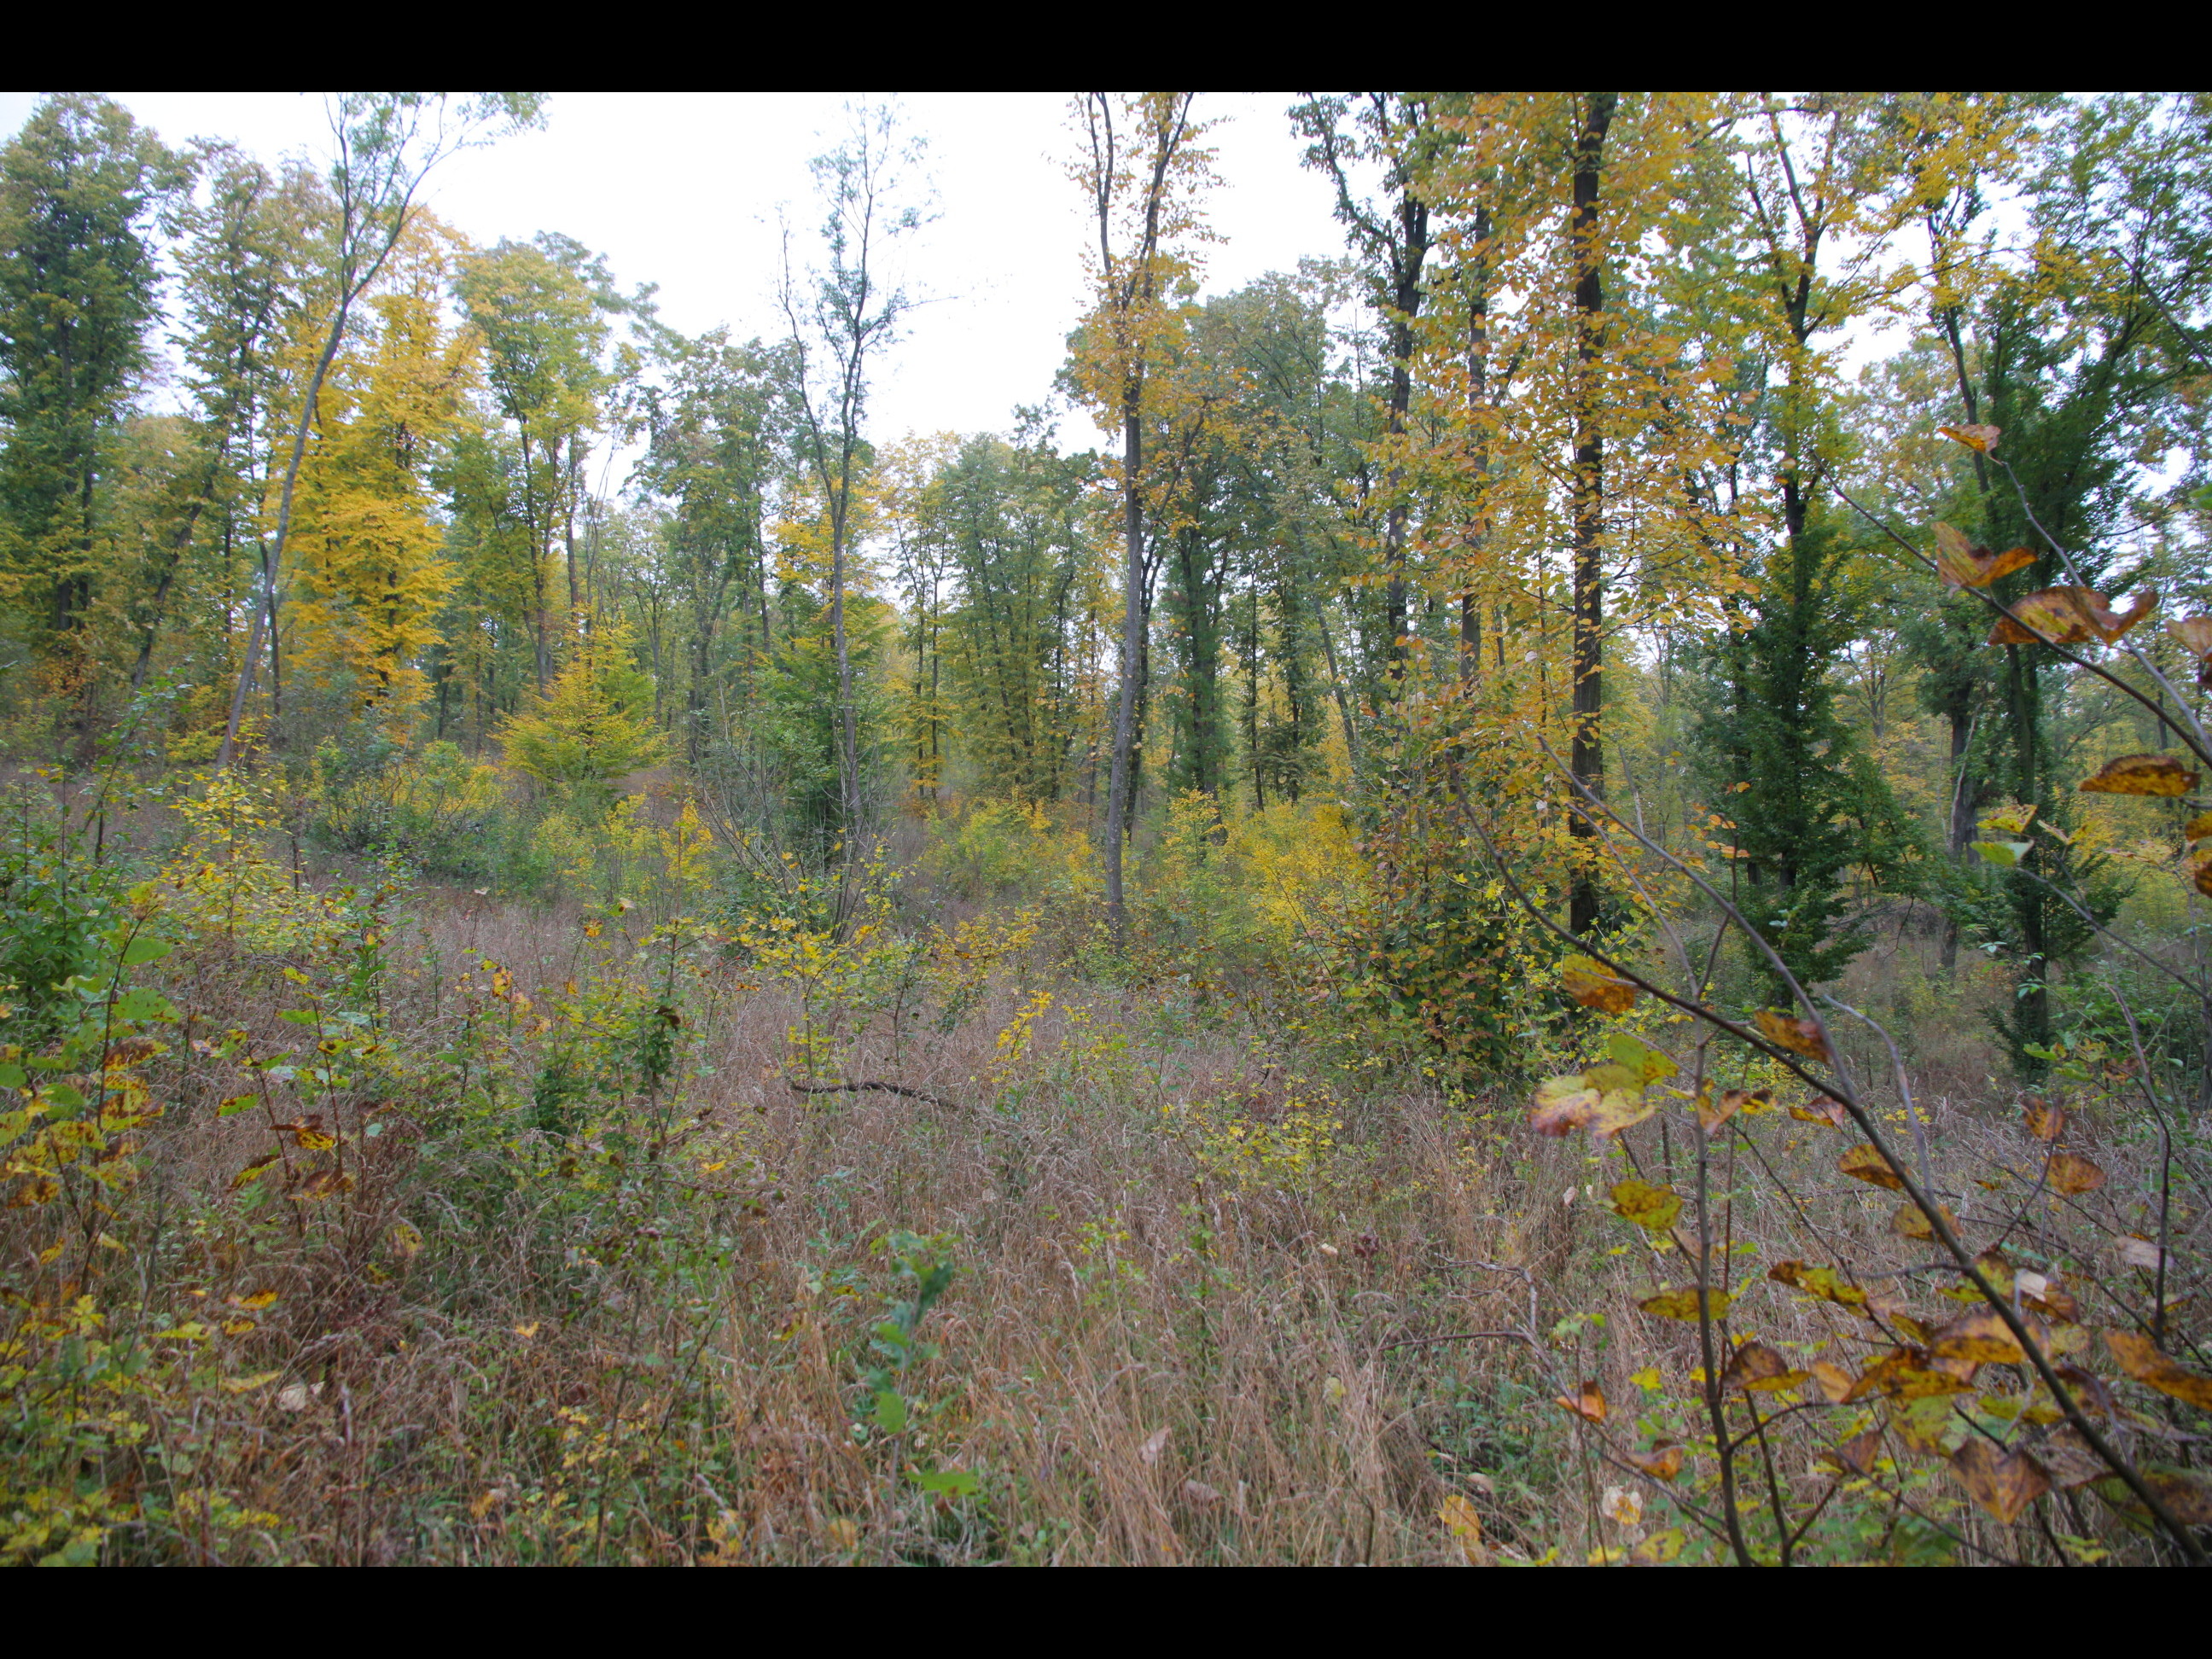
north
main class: Woodland
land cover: Broadleaved woodland
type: mesophytic deciduous forest
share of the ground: 50 - 75 %
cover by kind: broadleaved forest trees 70 %, herbaceous plants 20 %, shrubs 10 %
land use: Forestry
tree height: > 5 m
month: October
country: BG
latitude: 43.7980
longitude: 26.6802
